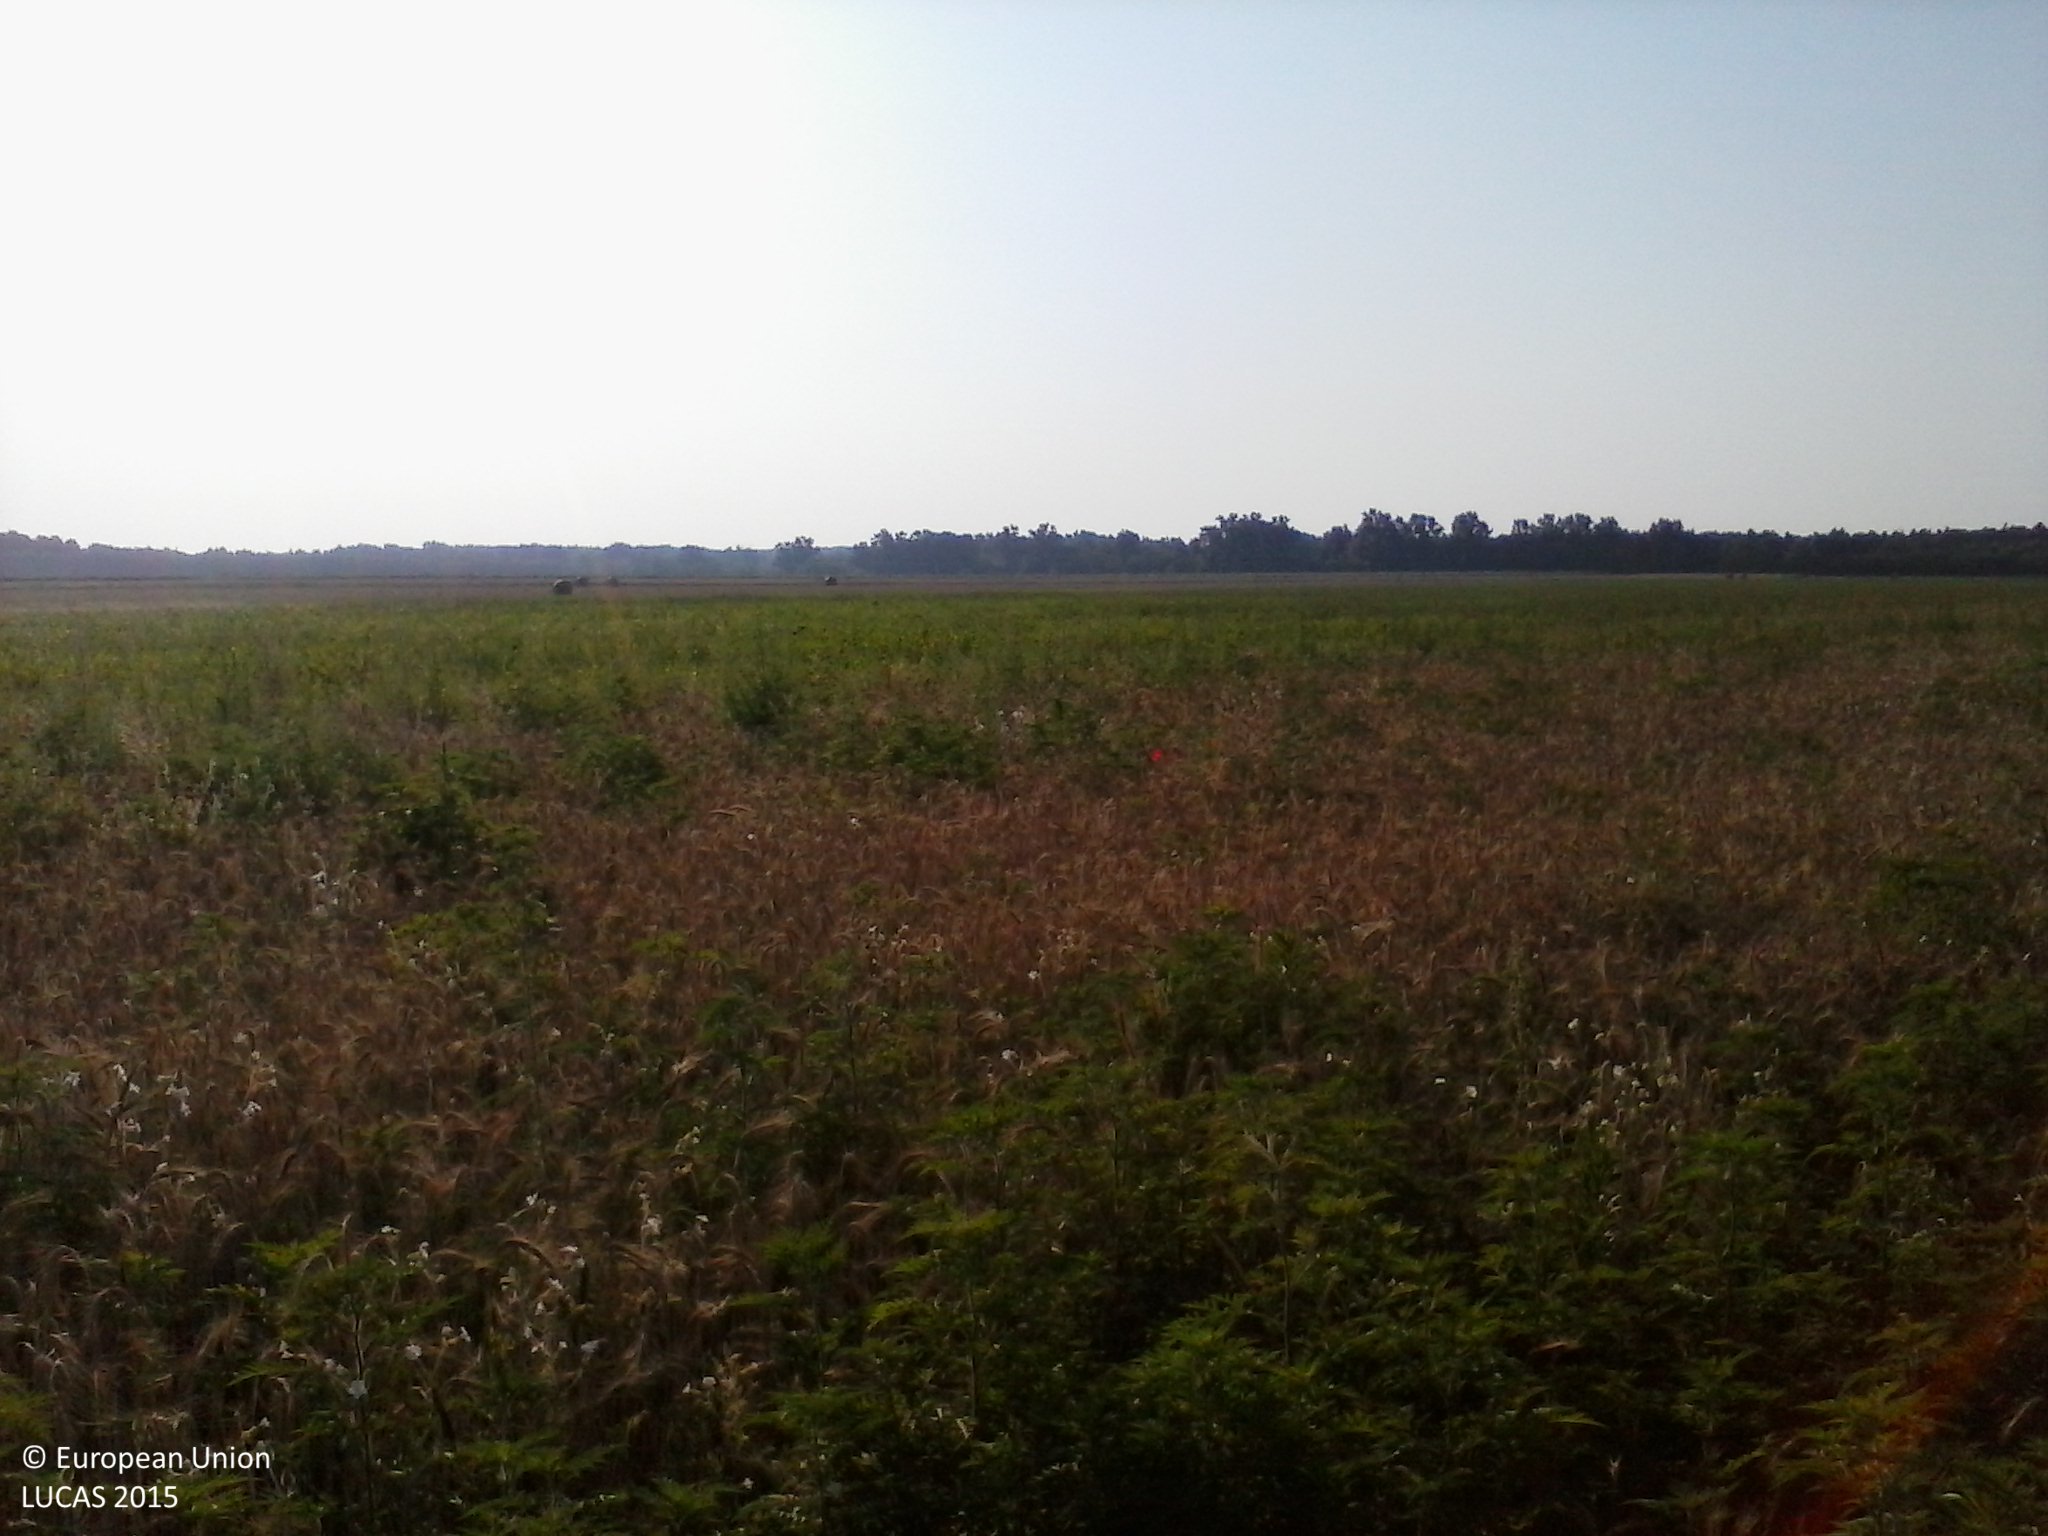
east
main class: Cropland
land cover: Common wheat
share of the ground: > 75 %
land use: Agriculture (excluding fallow land and kitchen gardens)
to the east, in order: Common wheat; Maize; Grassland without tree/shrub cover; Common wheat
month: July
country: HU
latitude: 46.4456
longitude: 19.5856
